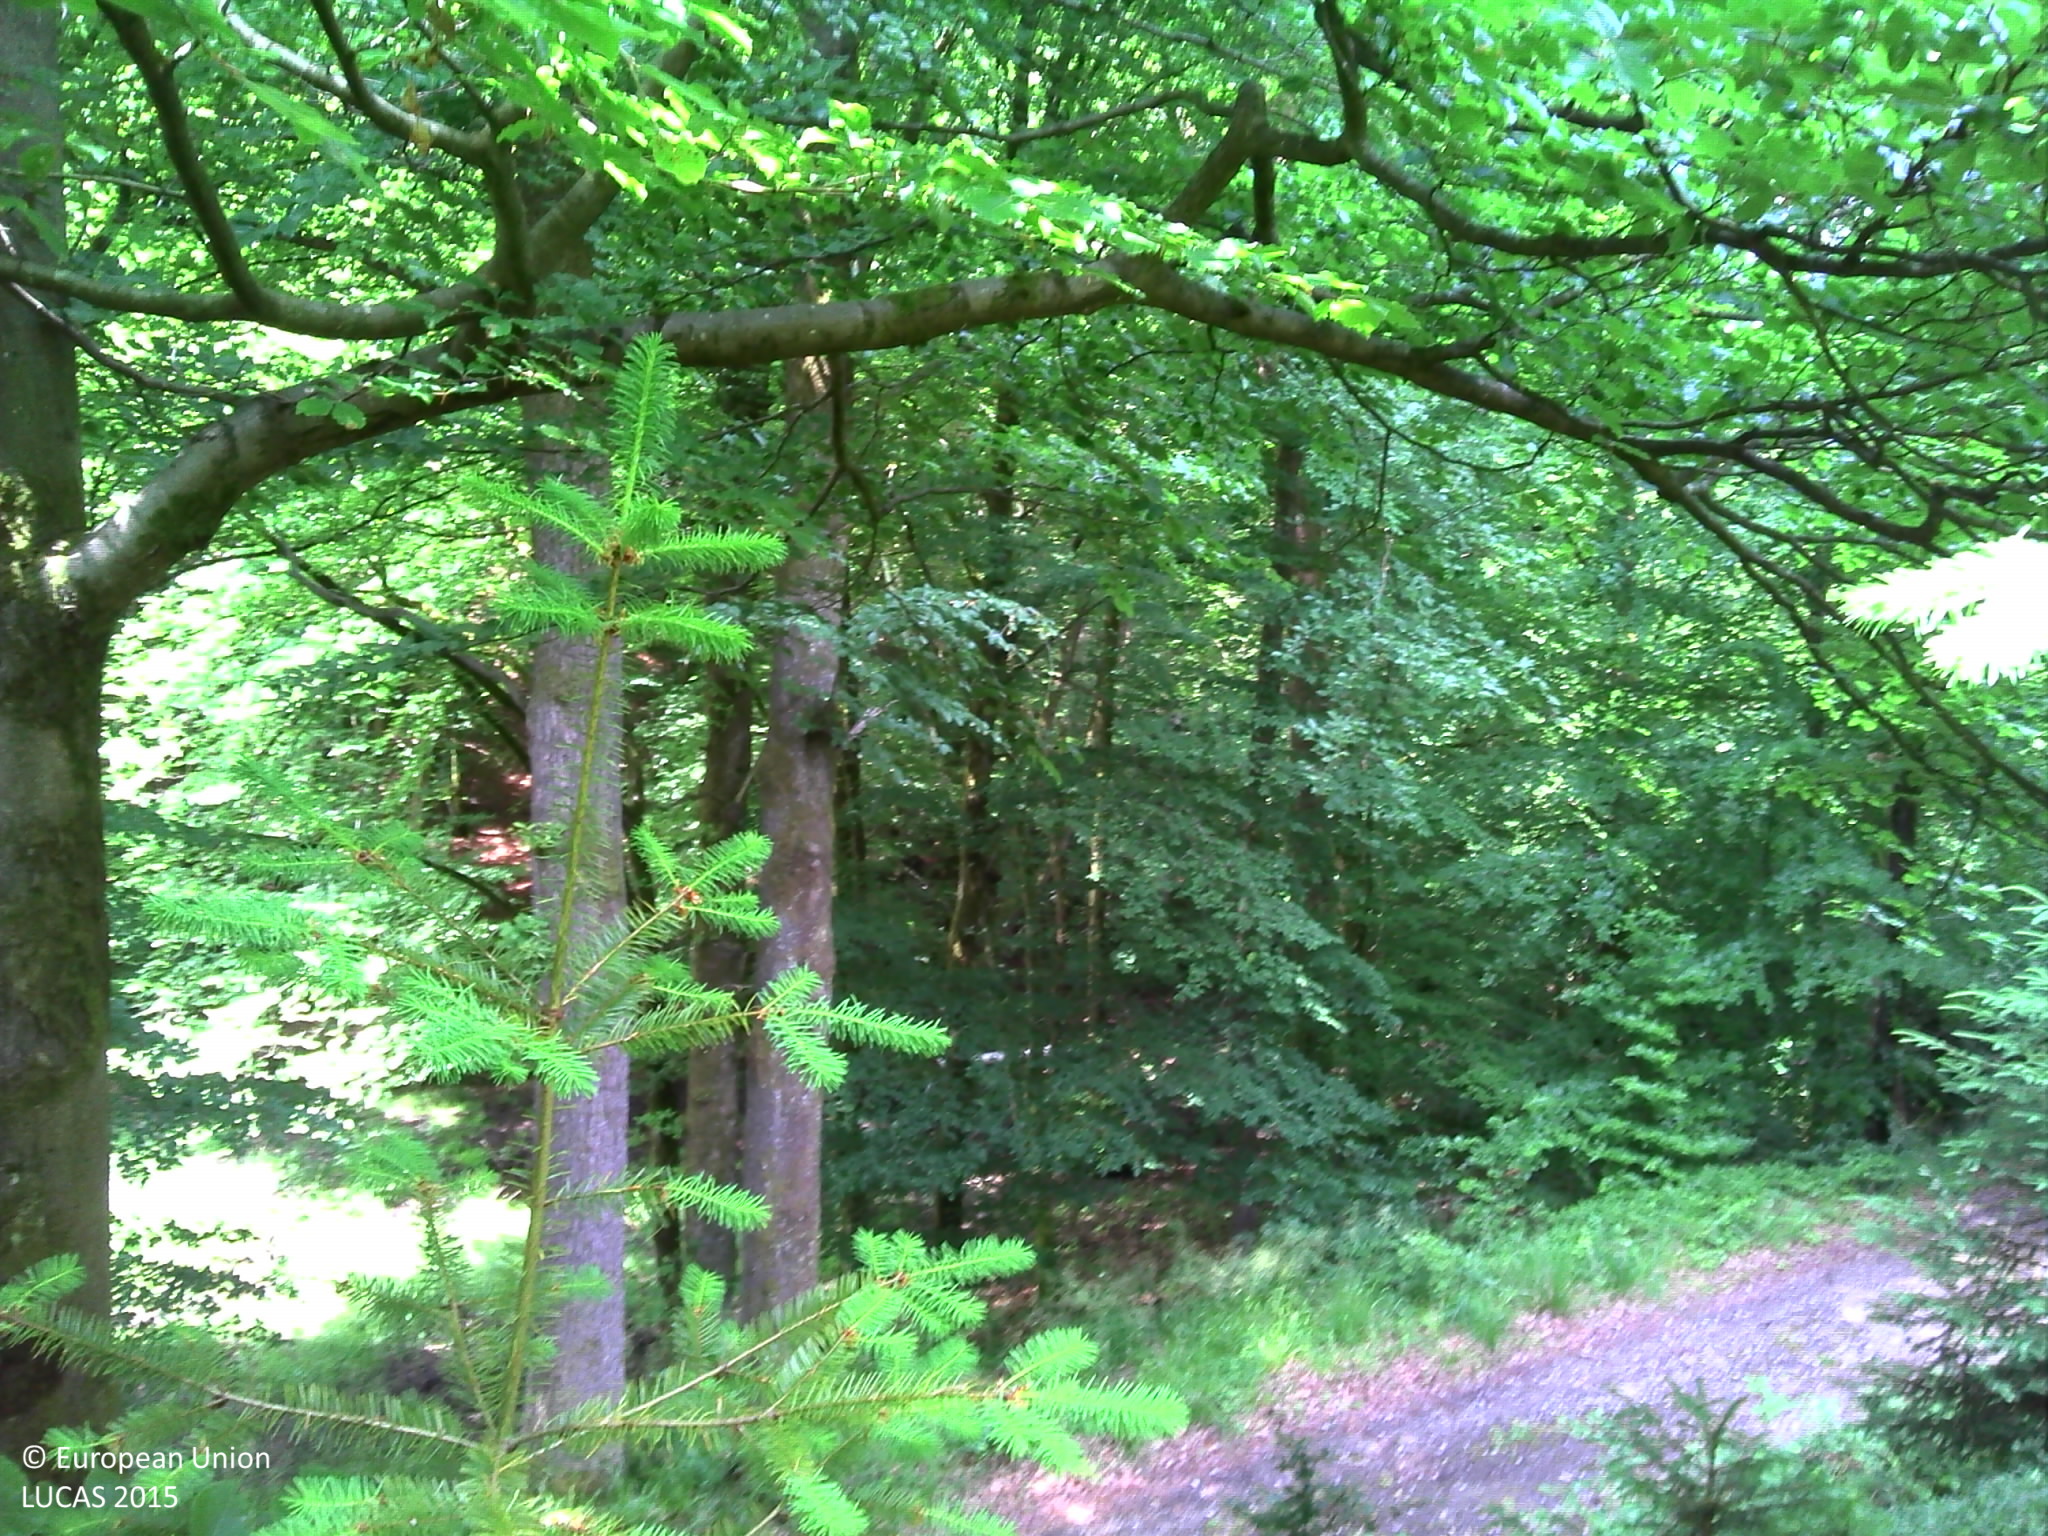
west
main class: Woodland
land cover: Other coniferous woodland
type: exotic forest
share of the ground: > 75 %
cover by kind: coniferous forest trees 90 %, broadleaved forest trees 5 %, shrubs 5 %
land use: Forestry
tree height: > 5 m
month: June
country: BE
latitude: 50.0319
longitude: 5.2653
